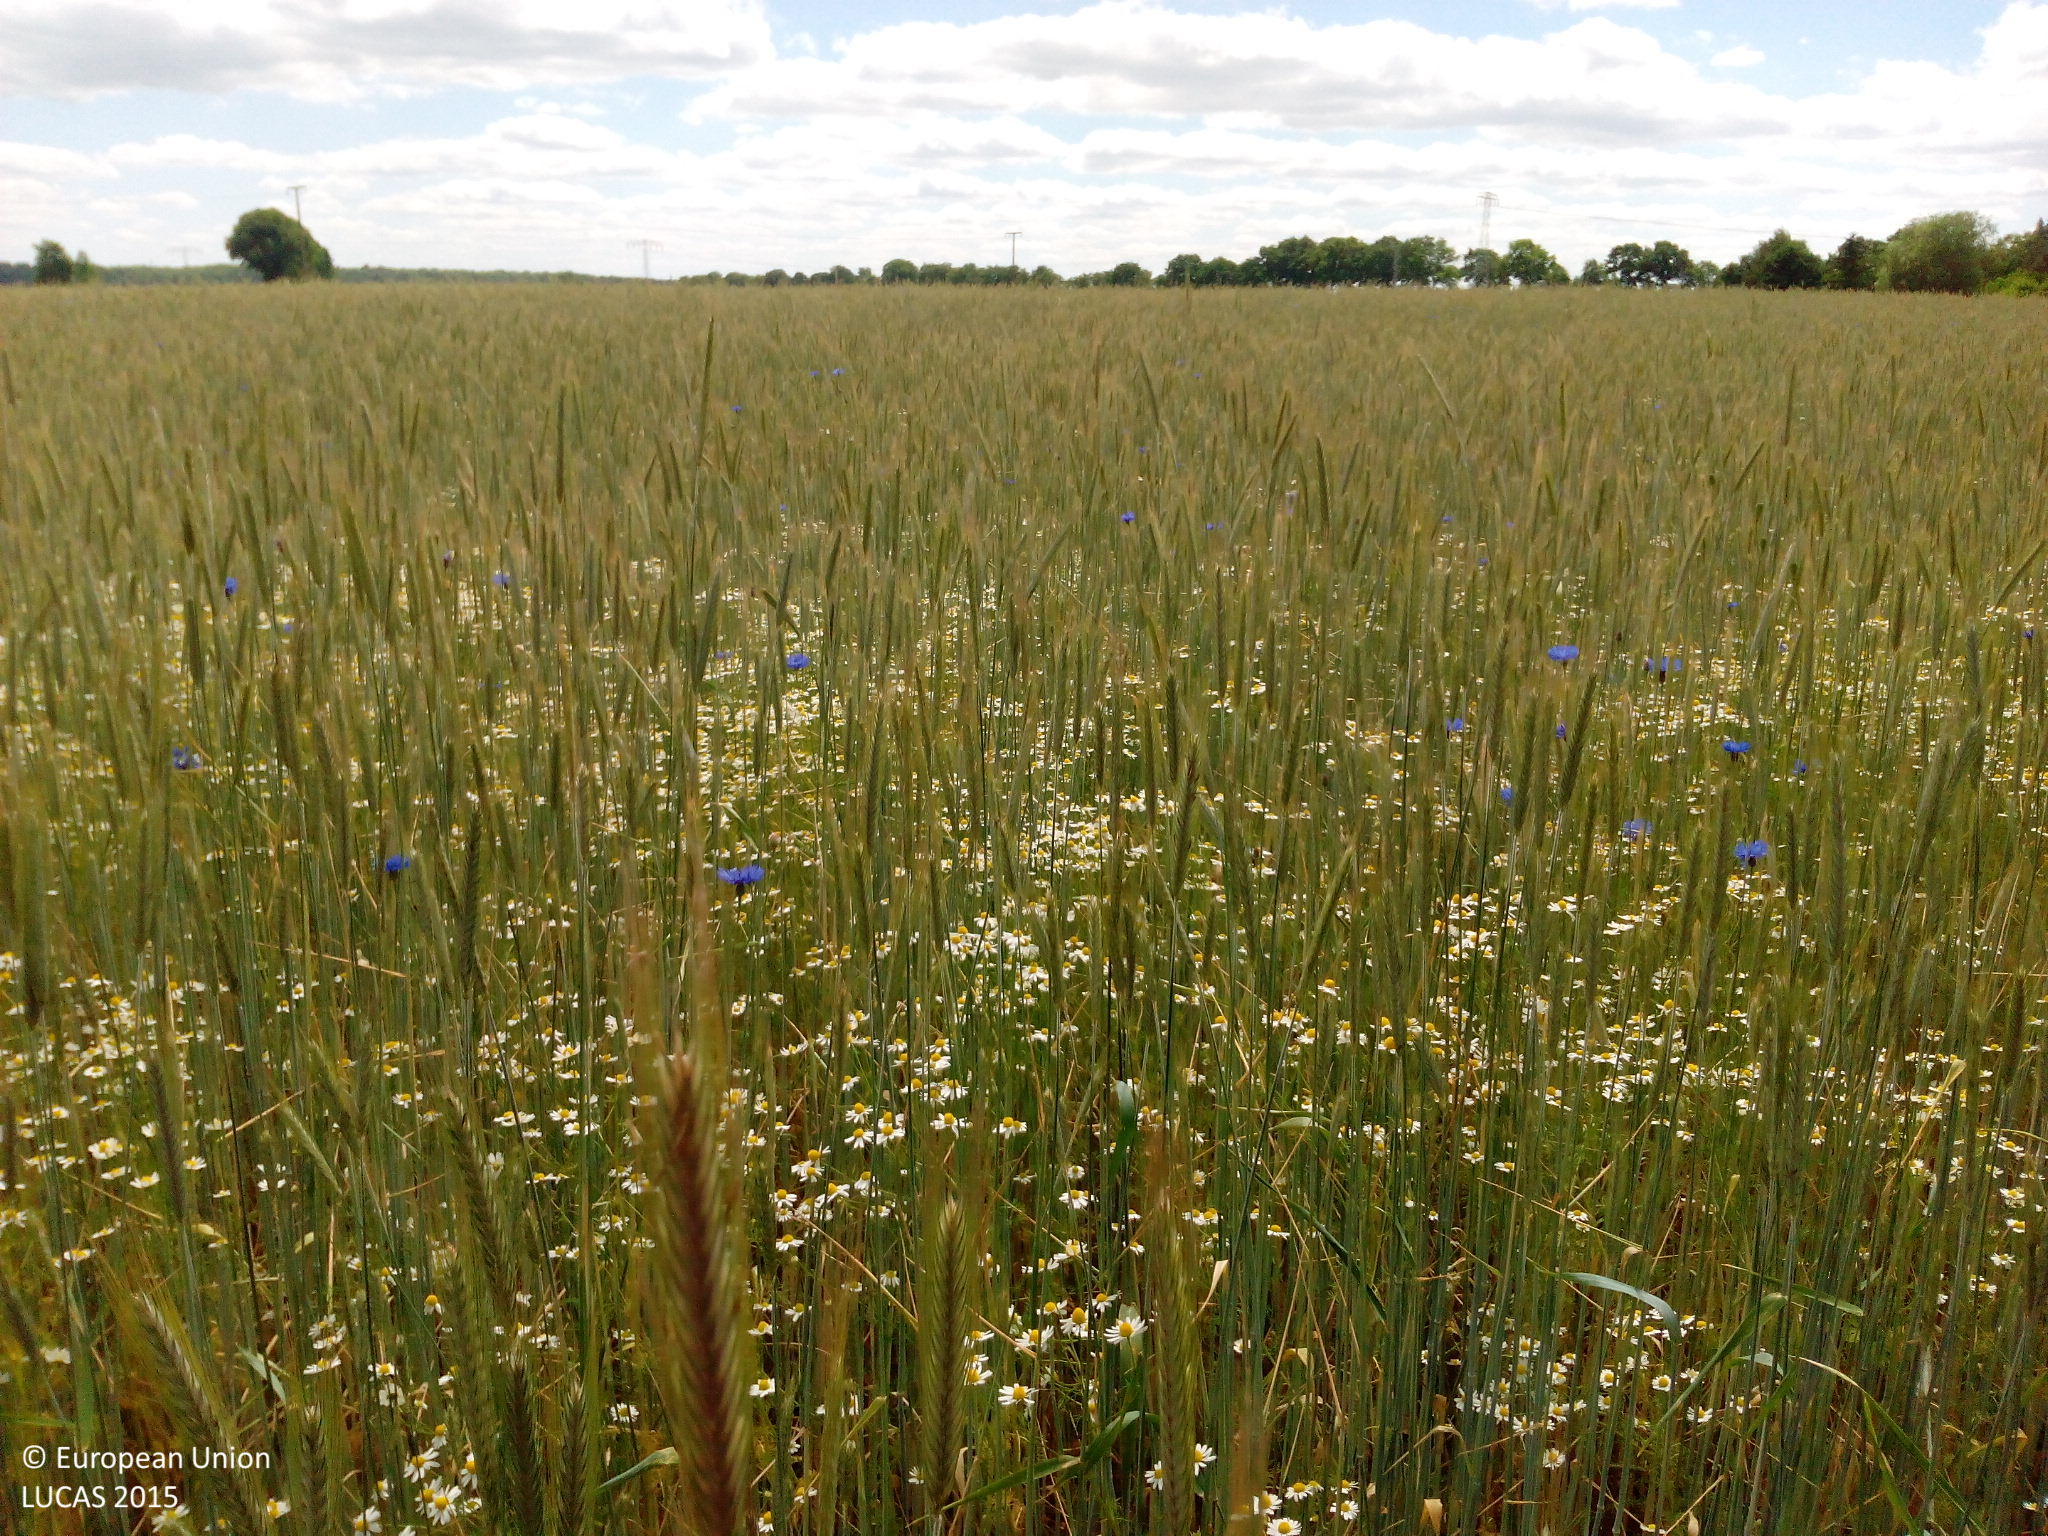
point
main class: Cropland
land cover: Rye
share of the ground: > 75 %
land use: Agriculture (excluding fallow land and kitchen gardens)
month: June
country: DE
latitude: 53.5541
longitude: 11.5239
